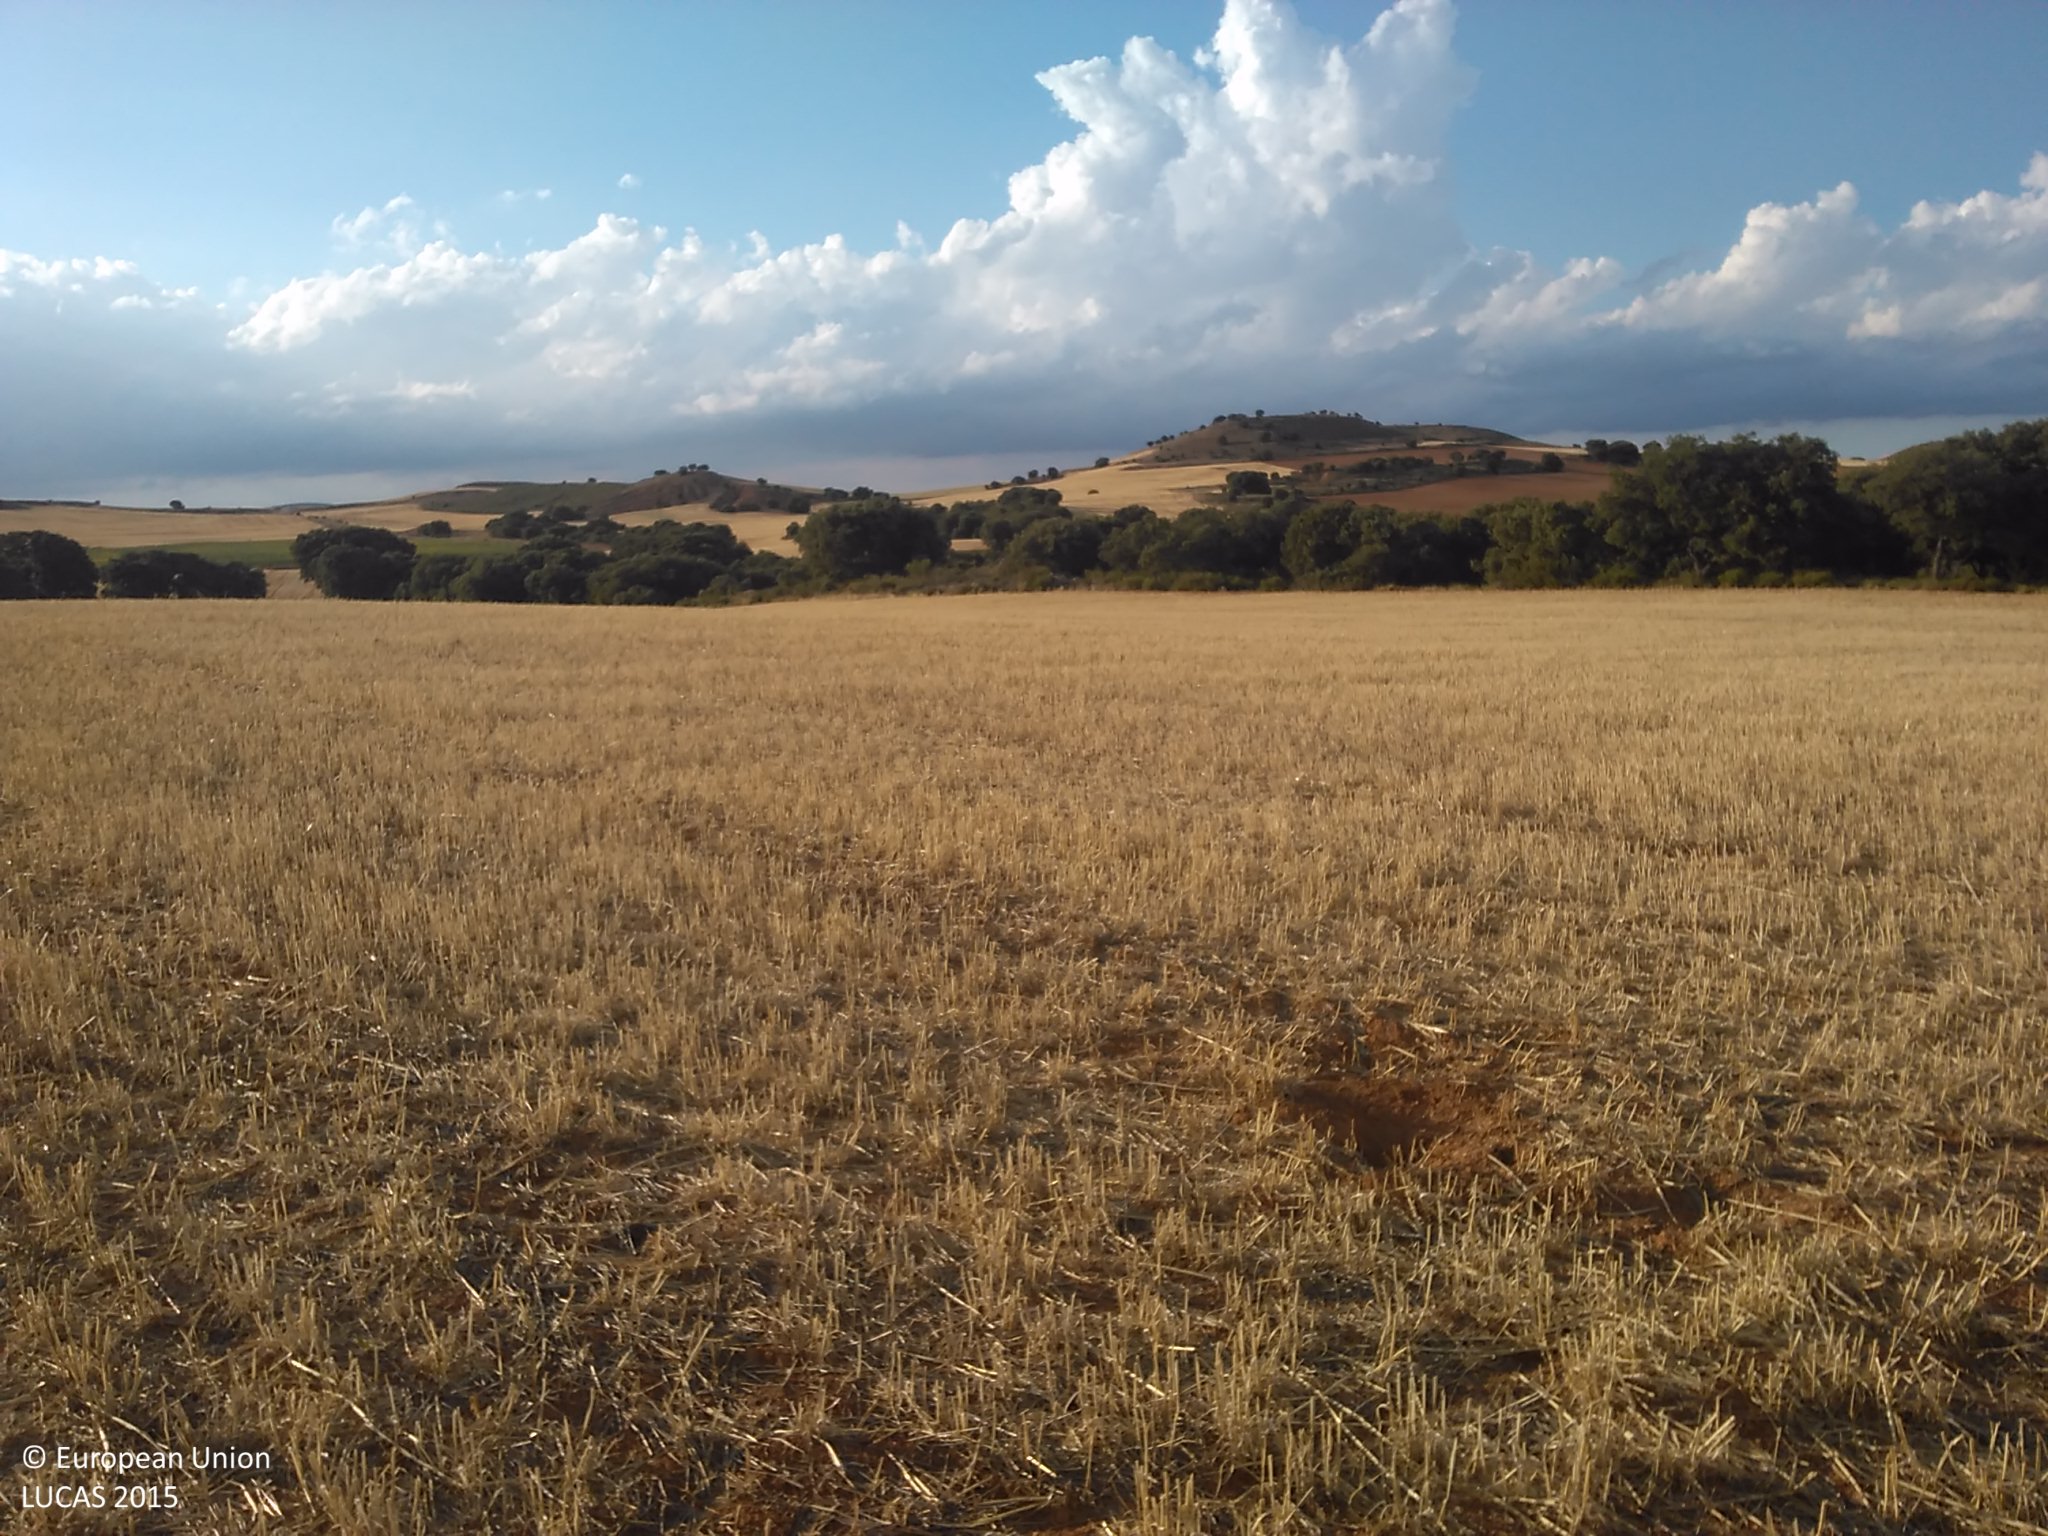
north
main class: Cropland
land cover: Barley
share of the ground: < 10 %
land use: Agriculture (excluding fallow land and kitchen gardens)
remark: Harvested field
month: July
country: ES
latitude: 41.4179
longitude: -2.2233
